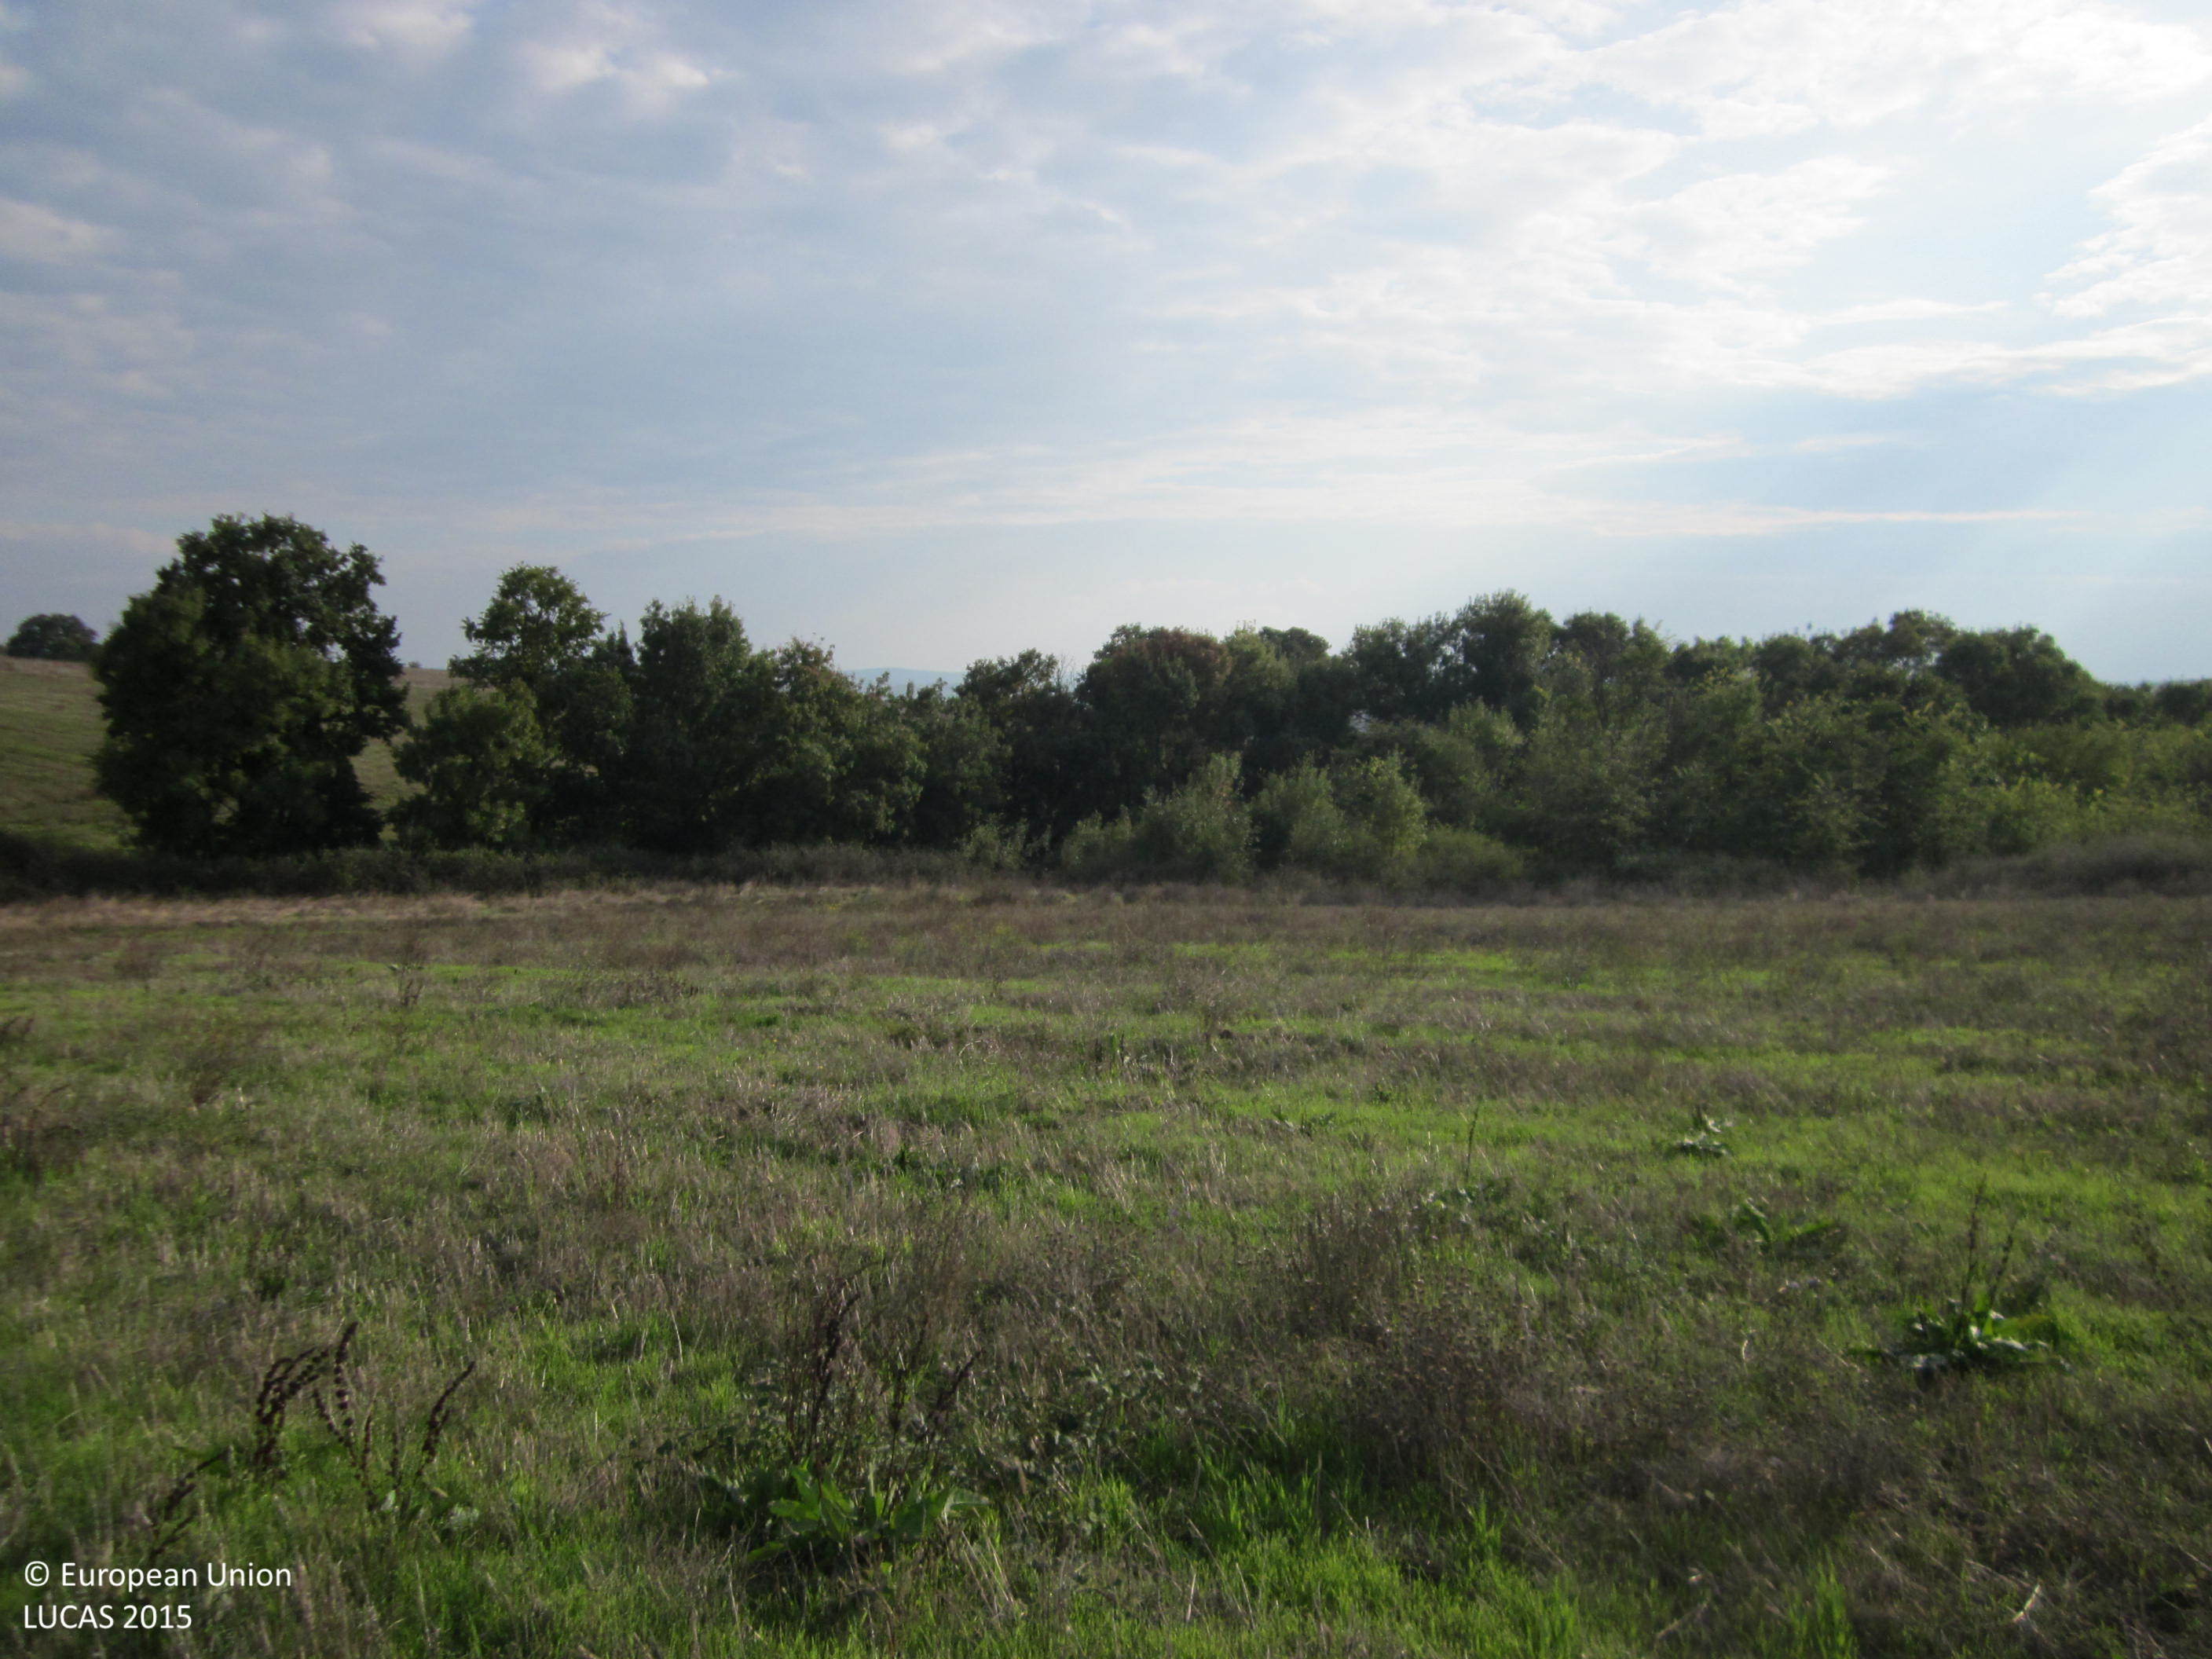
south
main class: Cropland
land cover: Barley
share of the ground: 10 - 25 %
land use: Agriculture (excluding fallow land and kitchen gardens)
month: October
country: BG
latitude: 42.3307
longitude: 26.9829
